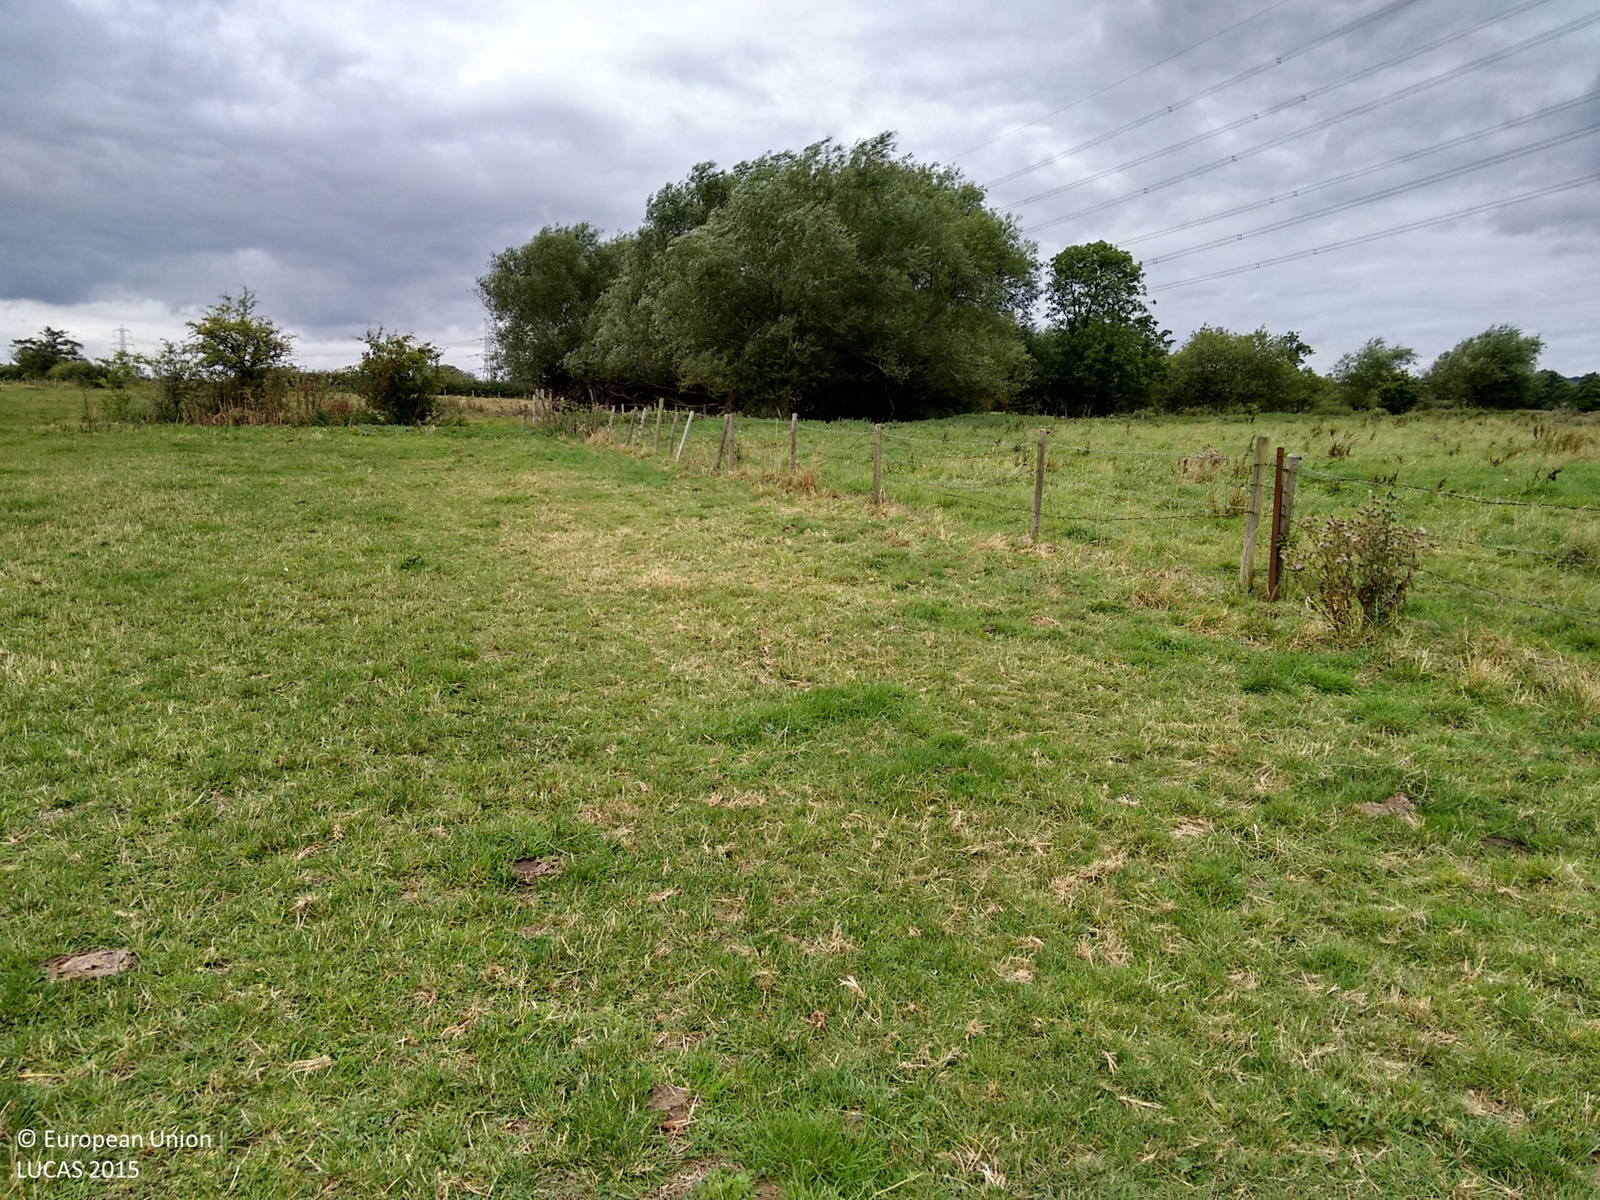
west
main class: Grassland
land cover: Grassland without tree/shrub cover
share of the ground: > 75 %
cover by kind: herbaceous plants 100 %
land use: Agriculture (excluding fallow land and kitchen gardens)
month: August
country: GB
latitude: 52.6412
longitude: -1.2343
